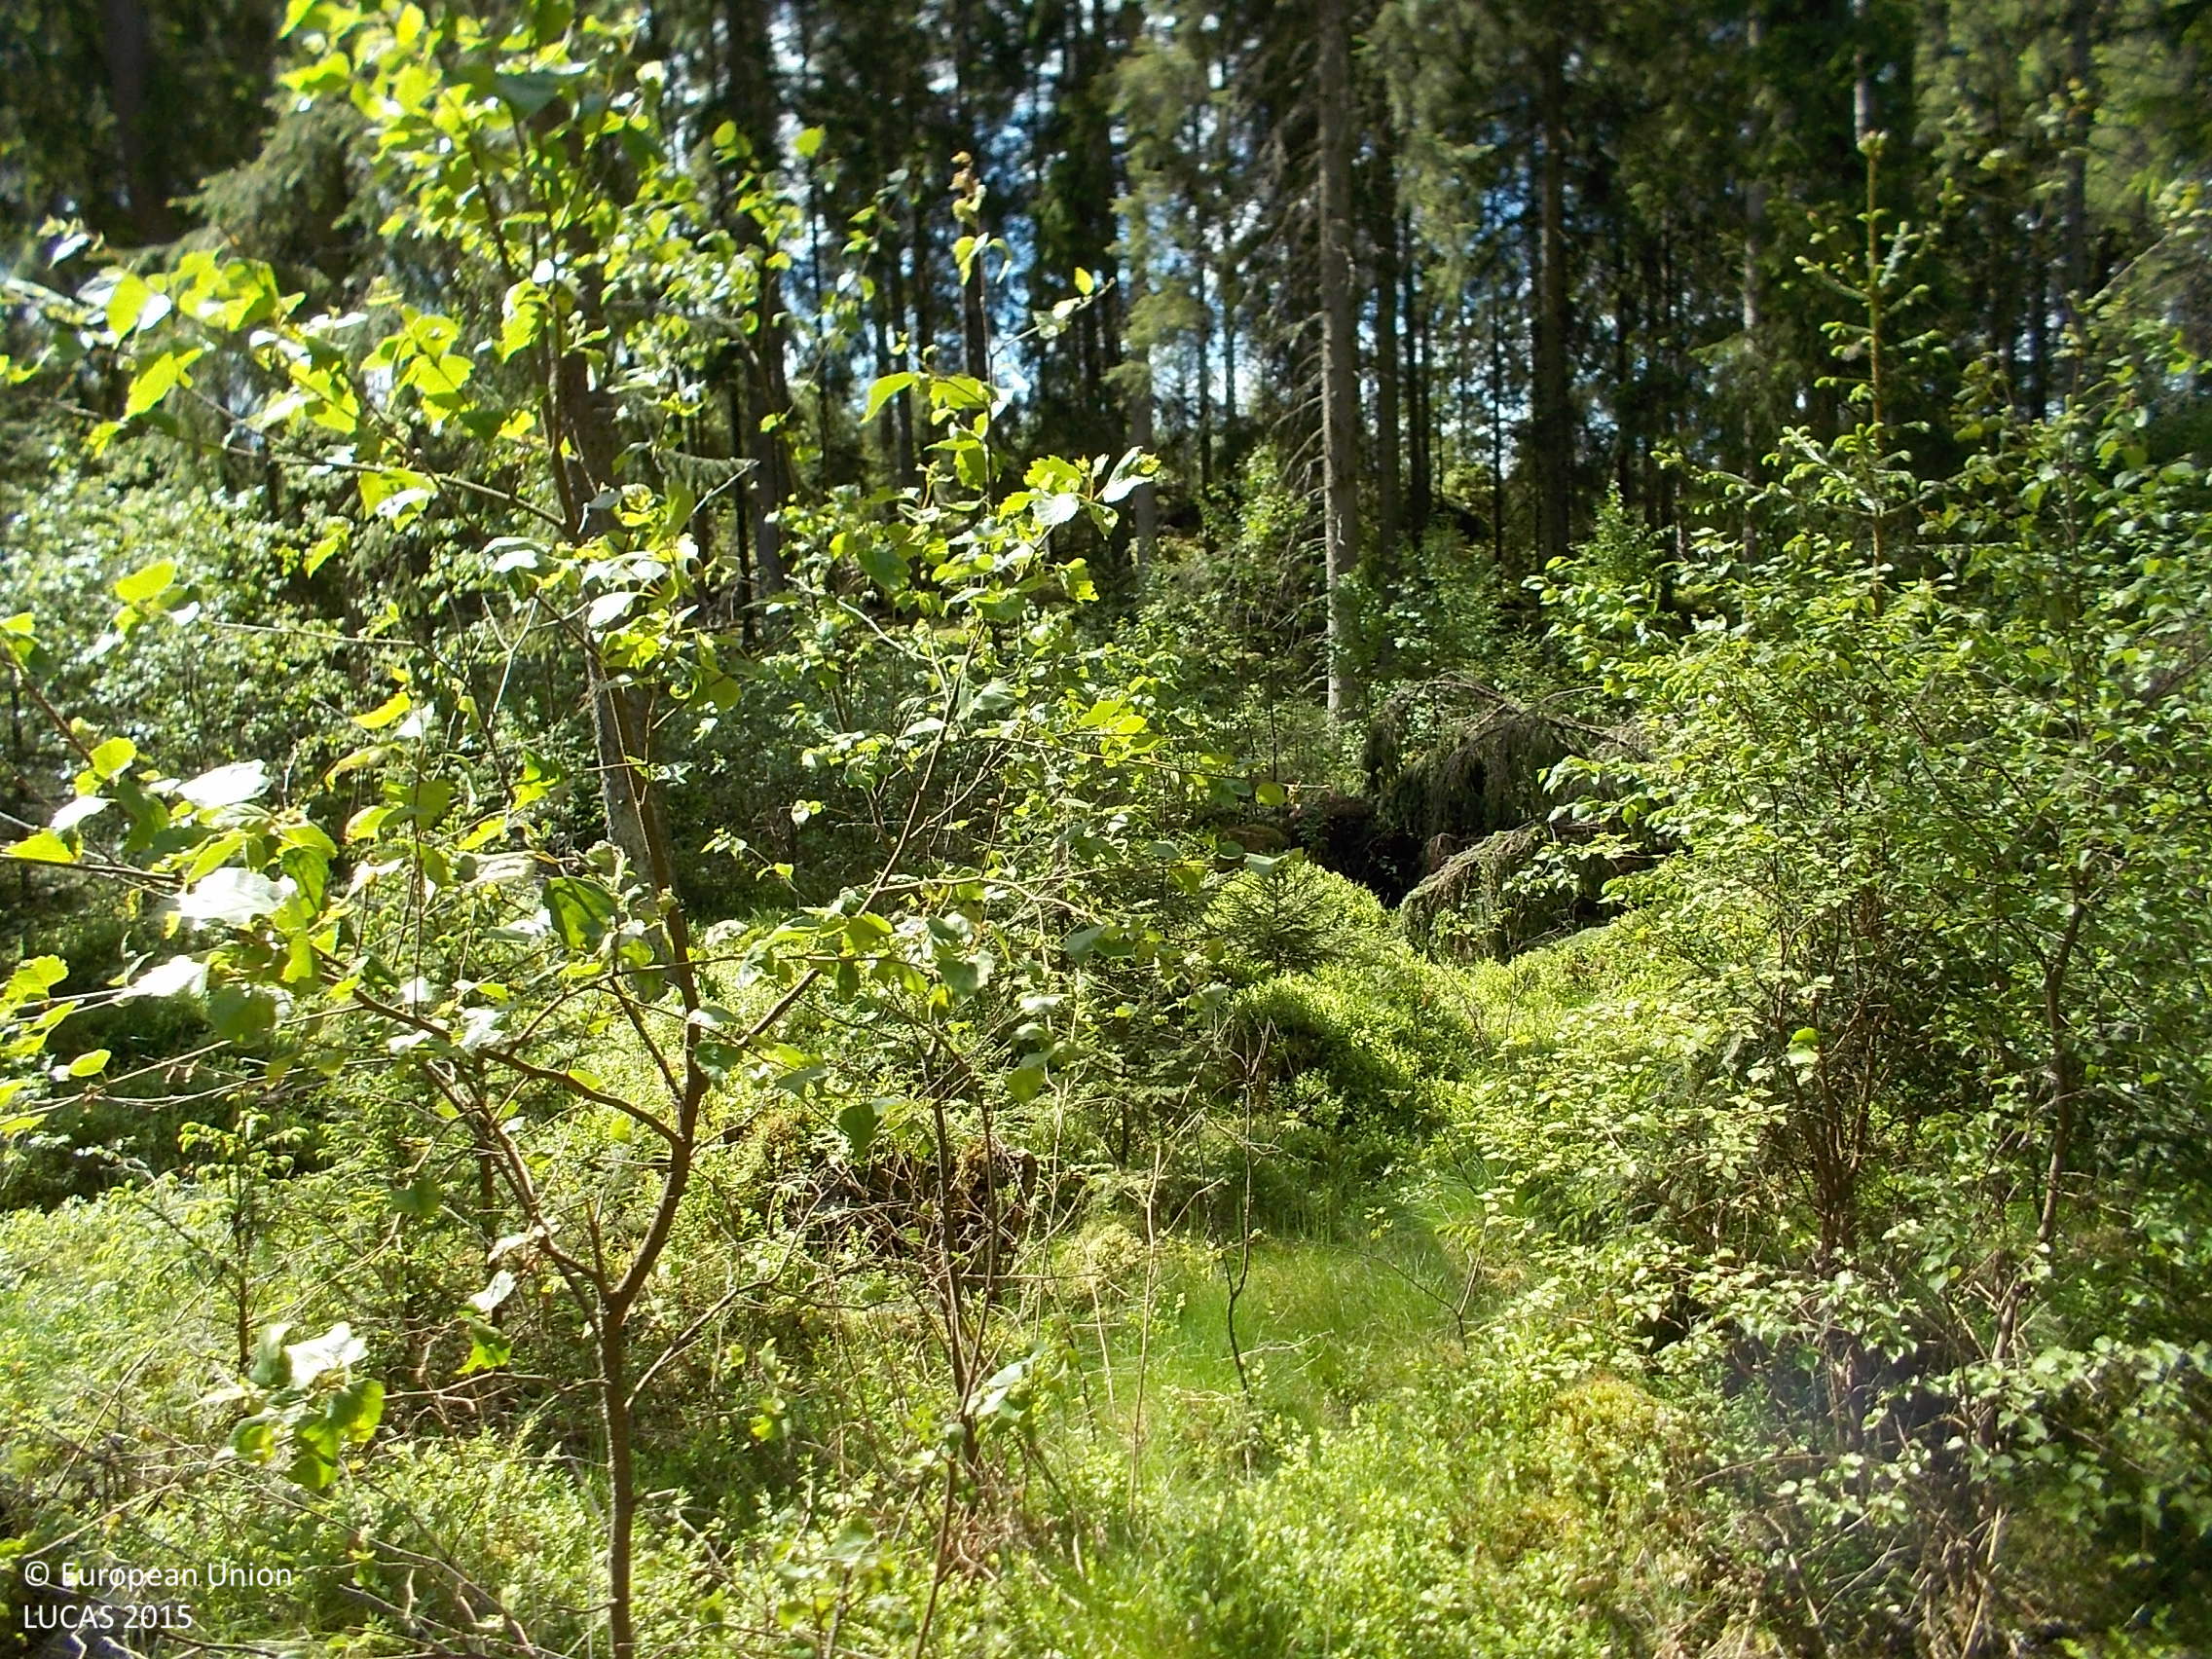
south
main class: Woodland
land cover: Spruce dominated coniferous woodland
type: boreal forest
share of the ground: 50 - 75 %
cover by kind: coniferous forest trees 70 %, shrubs 10 %, lichens and mosses 10 %, broadleaved forest trees 5 %, herbaceous plants 5 %
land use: Forestry
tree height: > 5 m
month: June
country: SE
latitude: 57.6759
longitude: 13.2652
